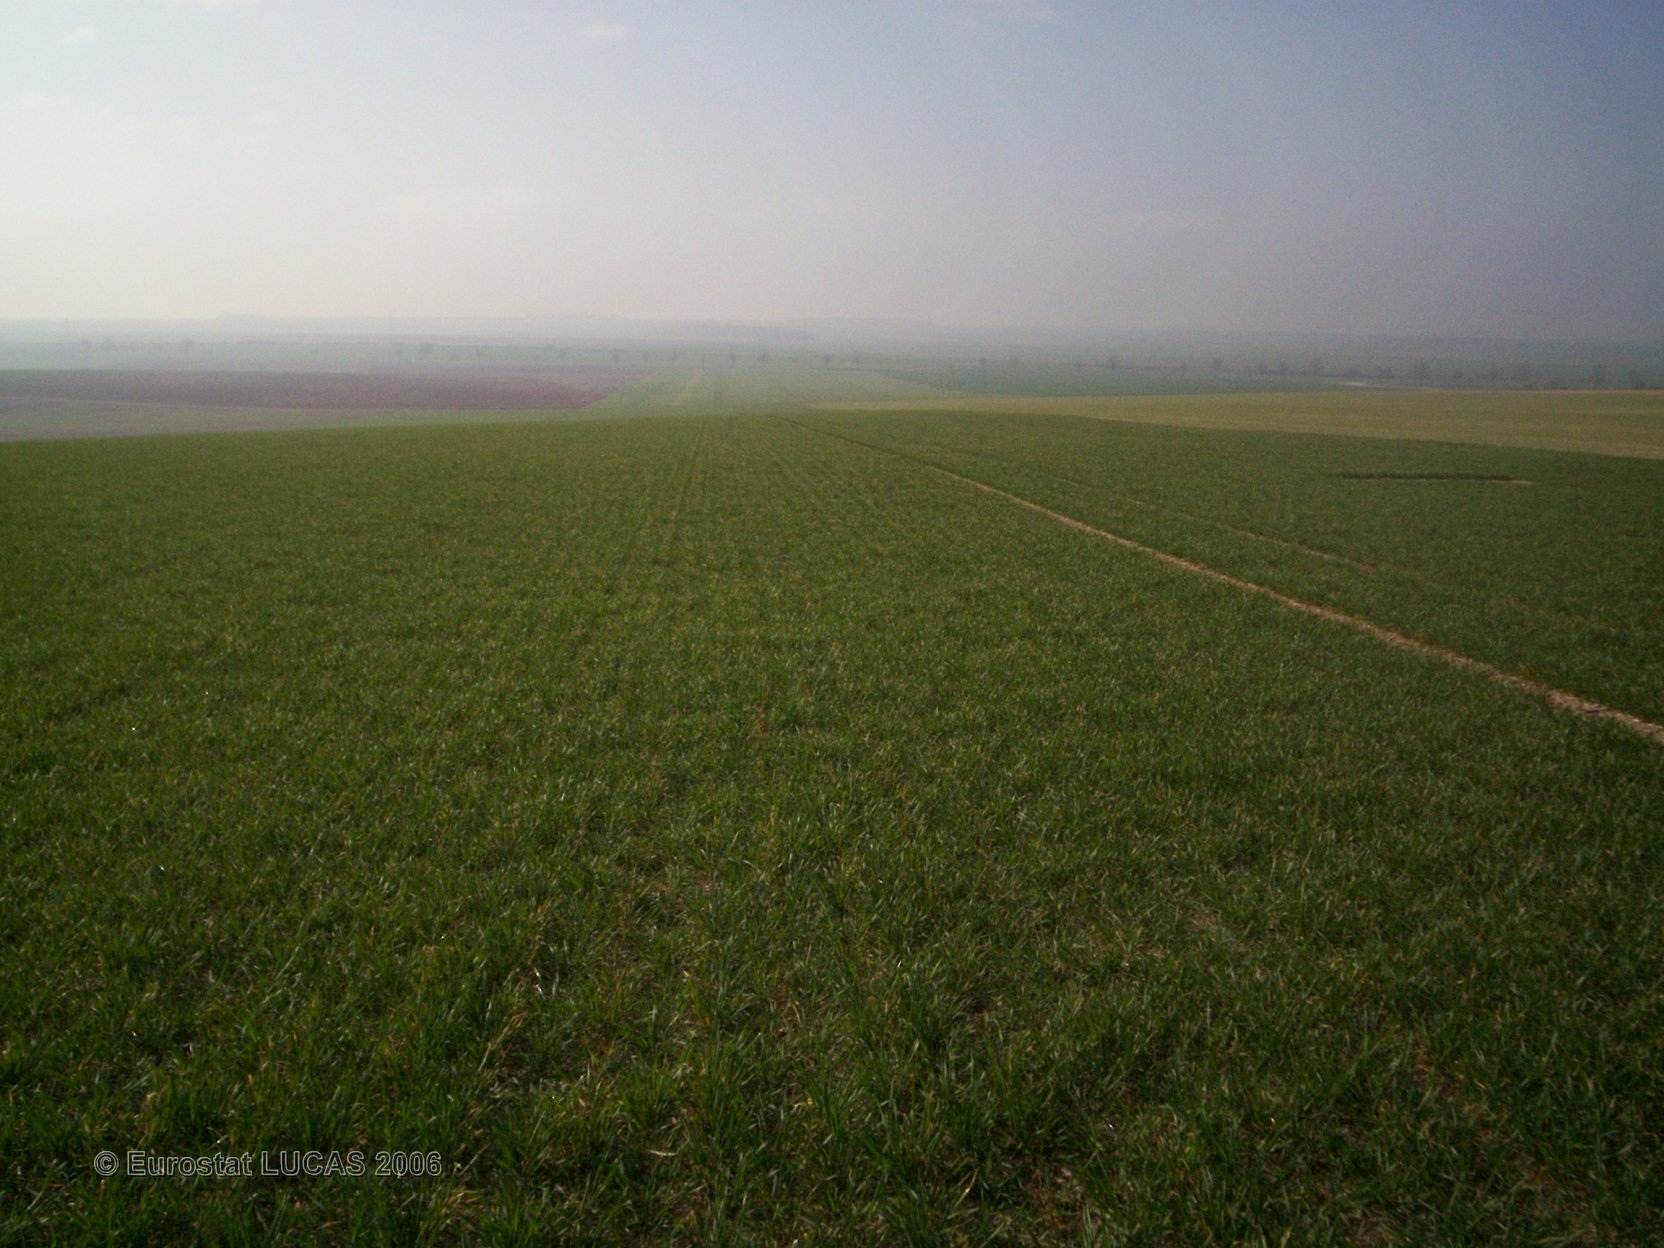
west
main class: Cropland
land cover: Barley
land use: Agriculture (excluding fallow land and kitchen gardens)
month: April
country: FR
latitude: 49.1196
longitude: 4.6121
